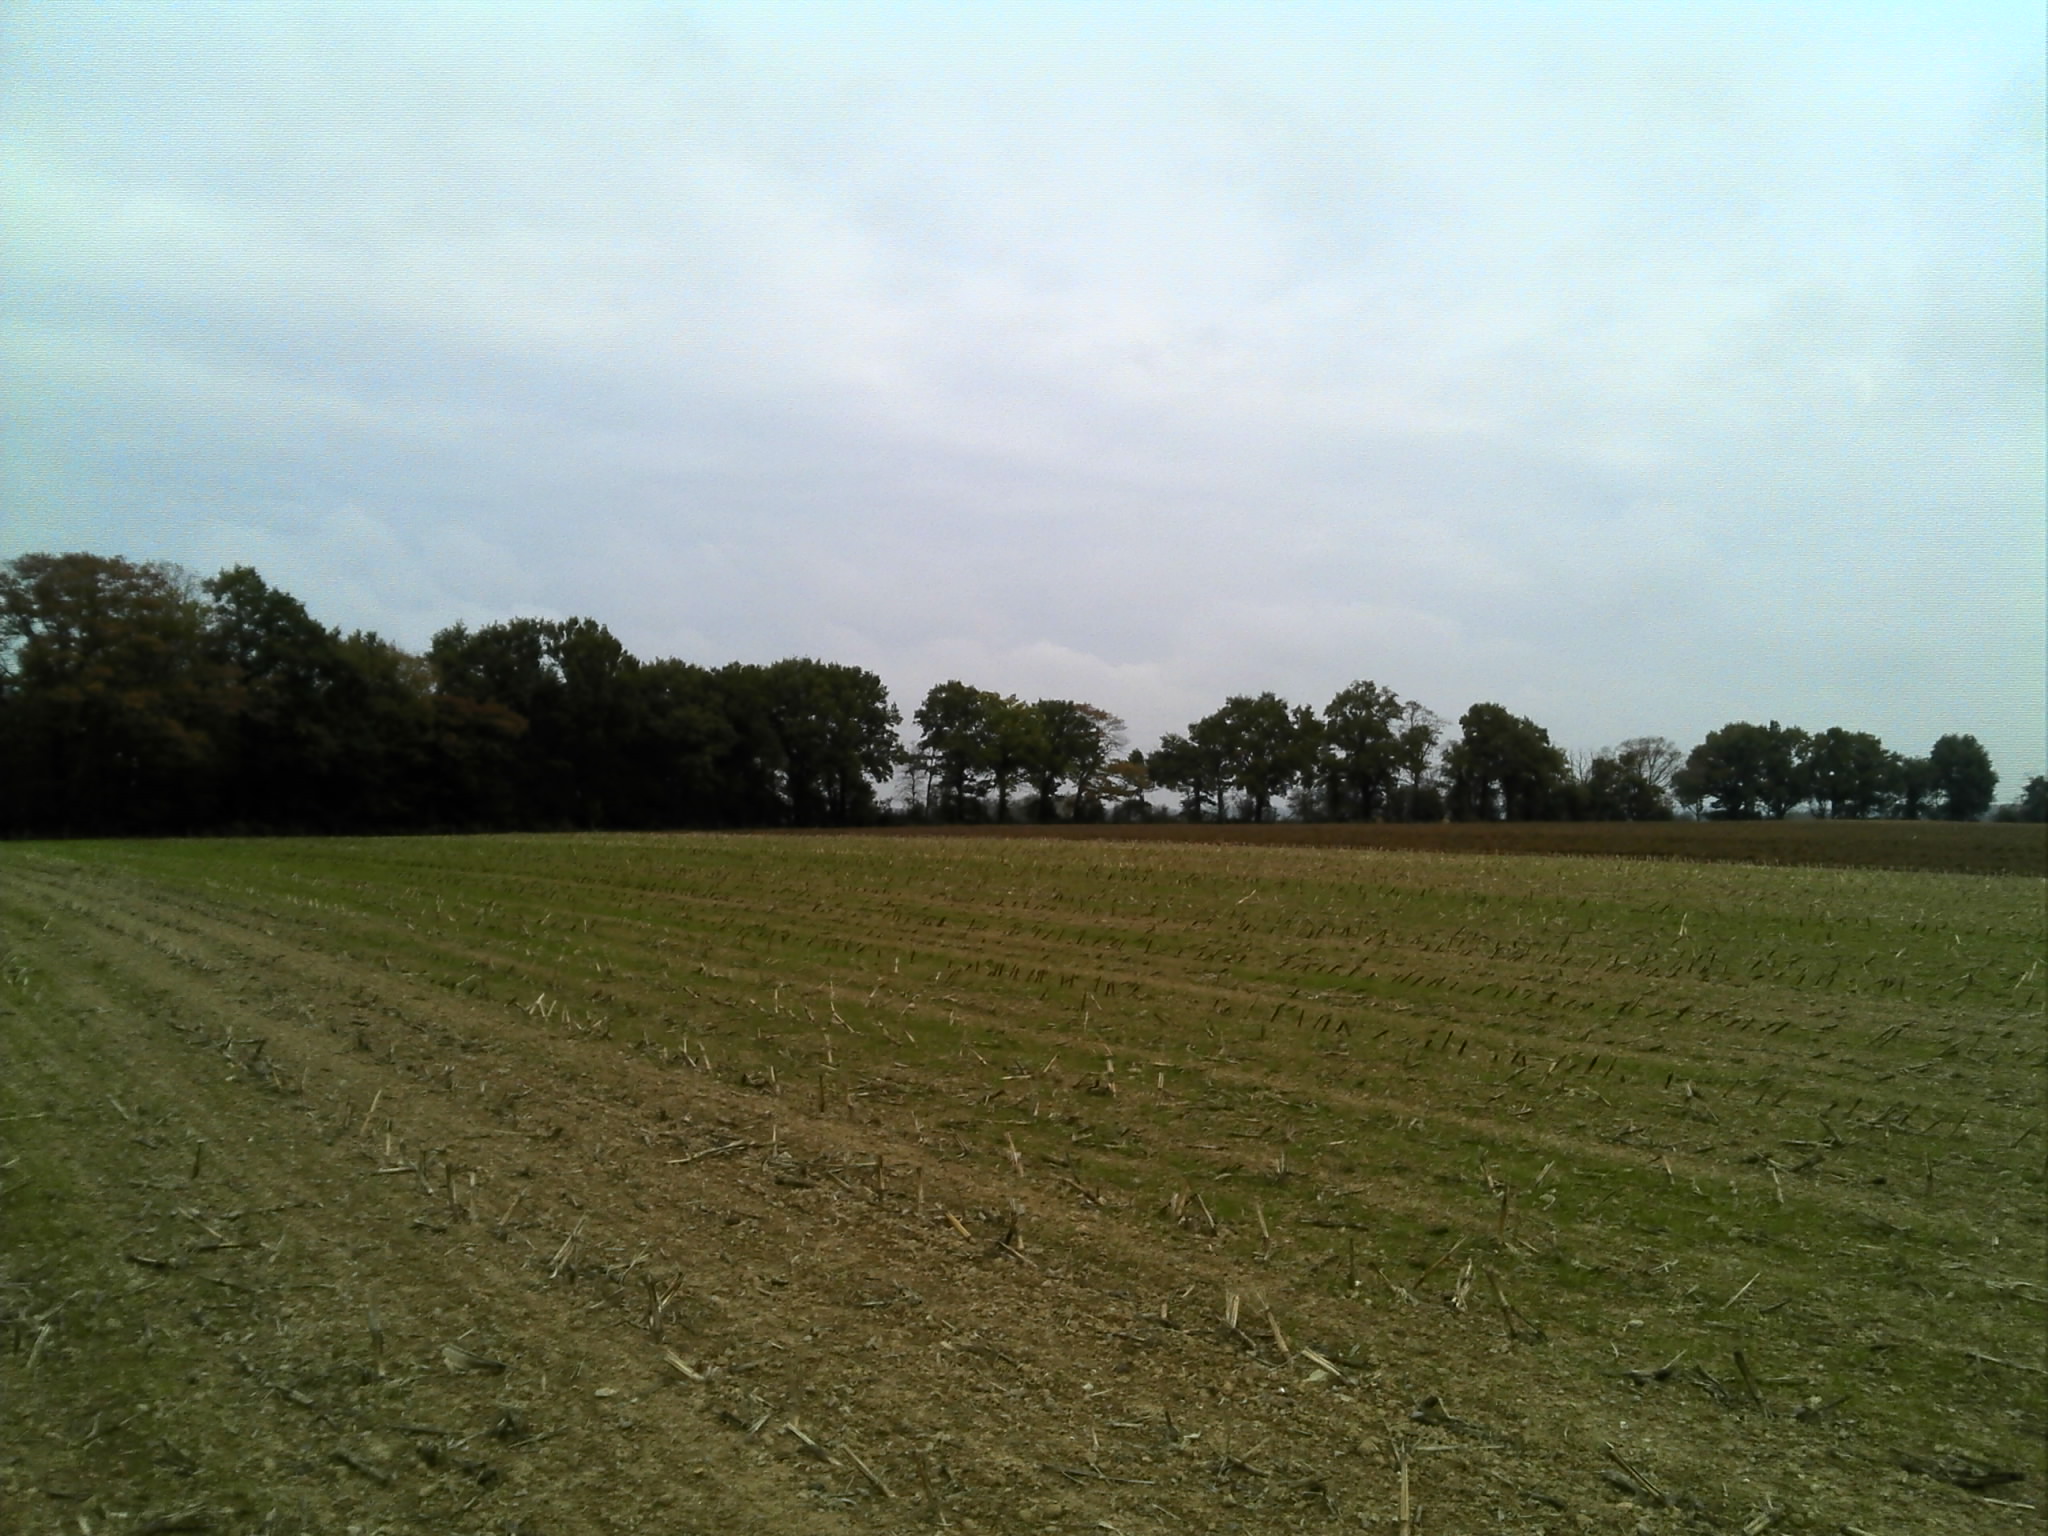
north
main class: Cropland
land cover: Temporary grasslands
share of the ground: 10 - 25 %
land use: Agriculture (excluding fallow land and kitchen gardens)
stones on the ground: 10 - 25 %
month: October
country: FR
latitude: 47.2573
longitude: -0.9636
